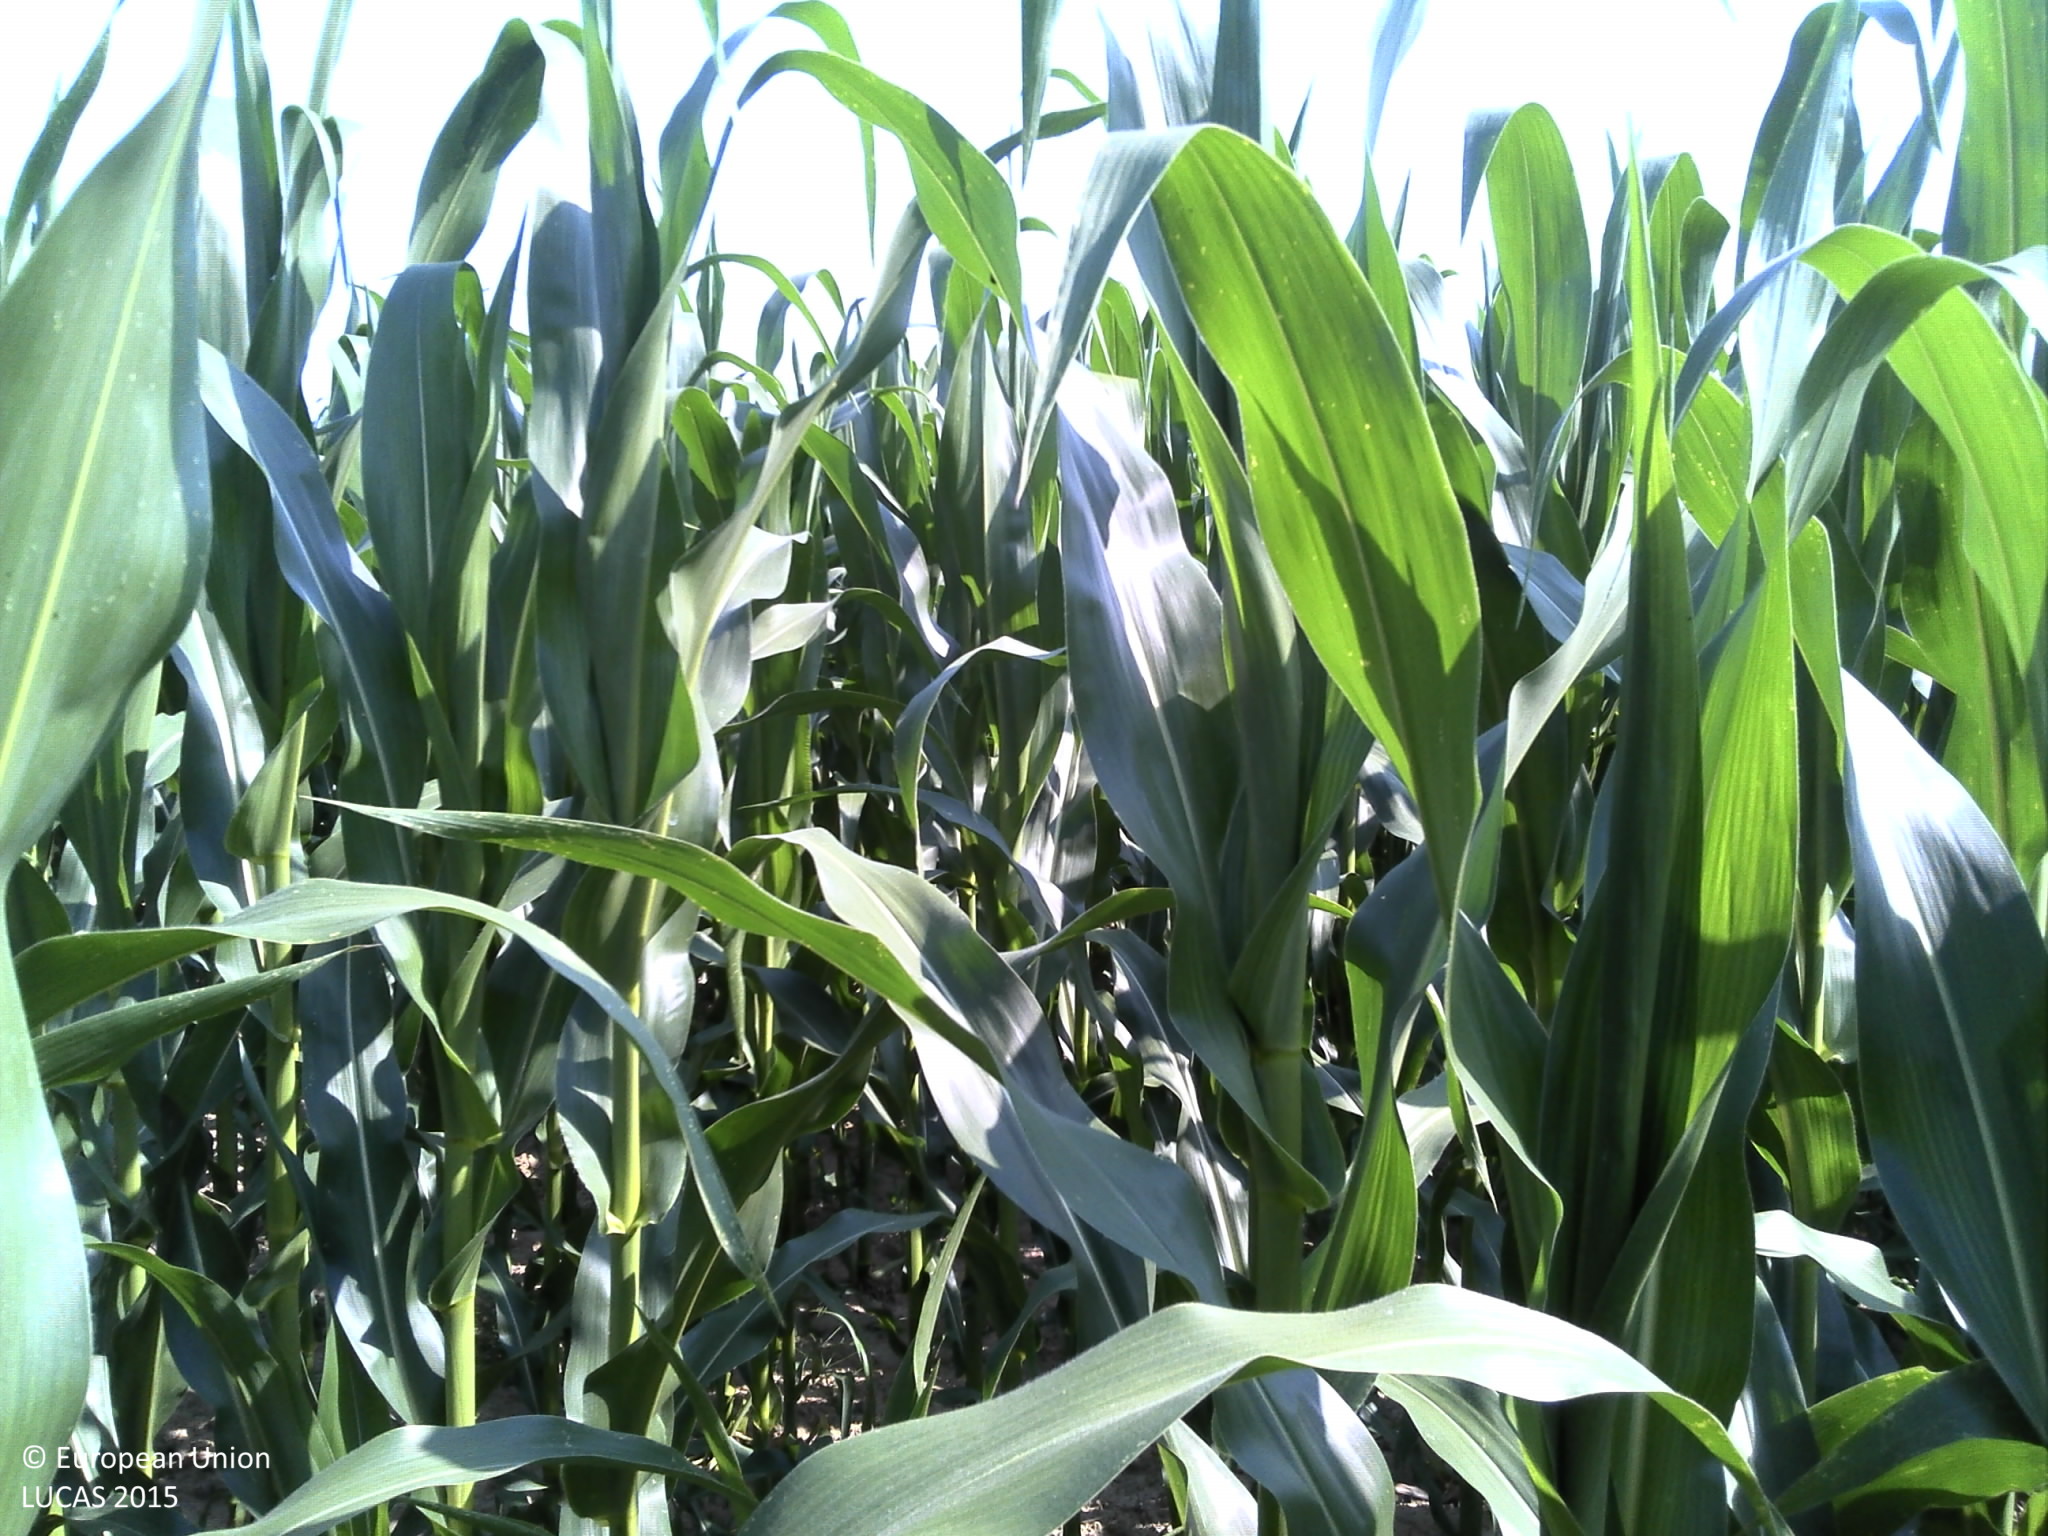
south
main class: Cropland
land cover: Maize
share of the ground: > 75 %
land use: Agriculture (excluding fallow land and kitchen gardens)
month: July
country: HR
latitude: 45.8007
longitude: 16.6514
